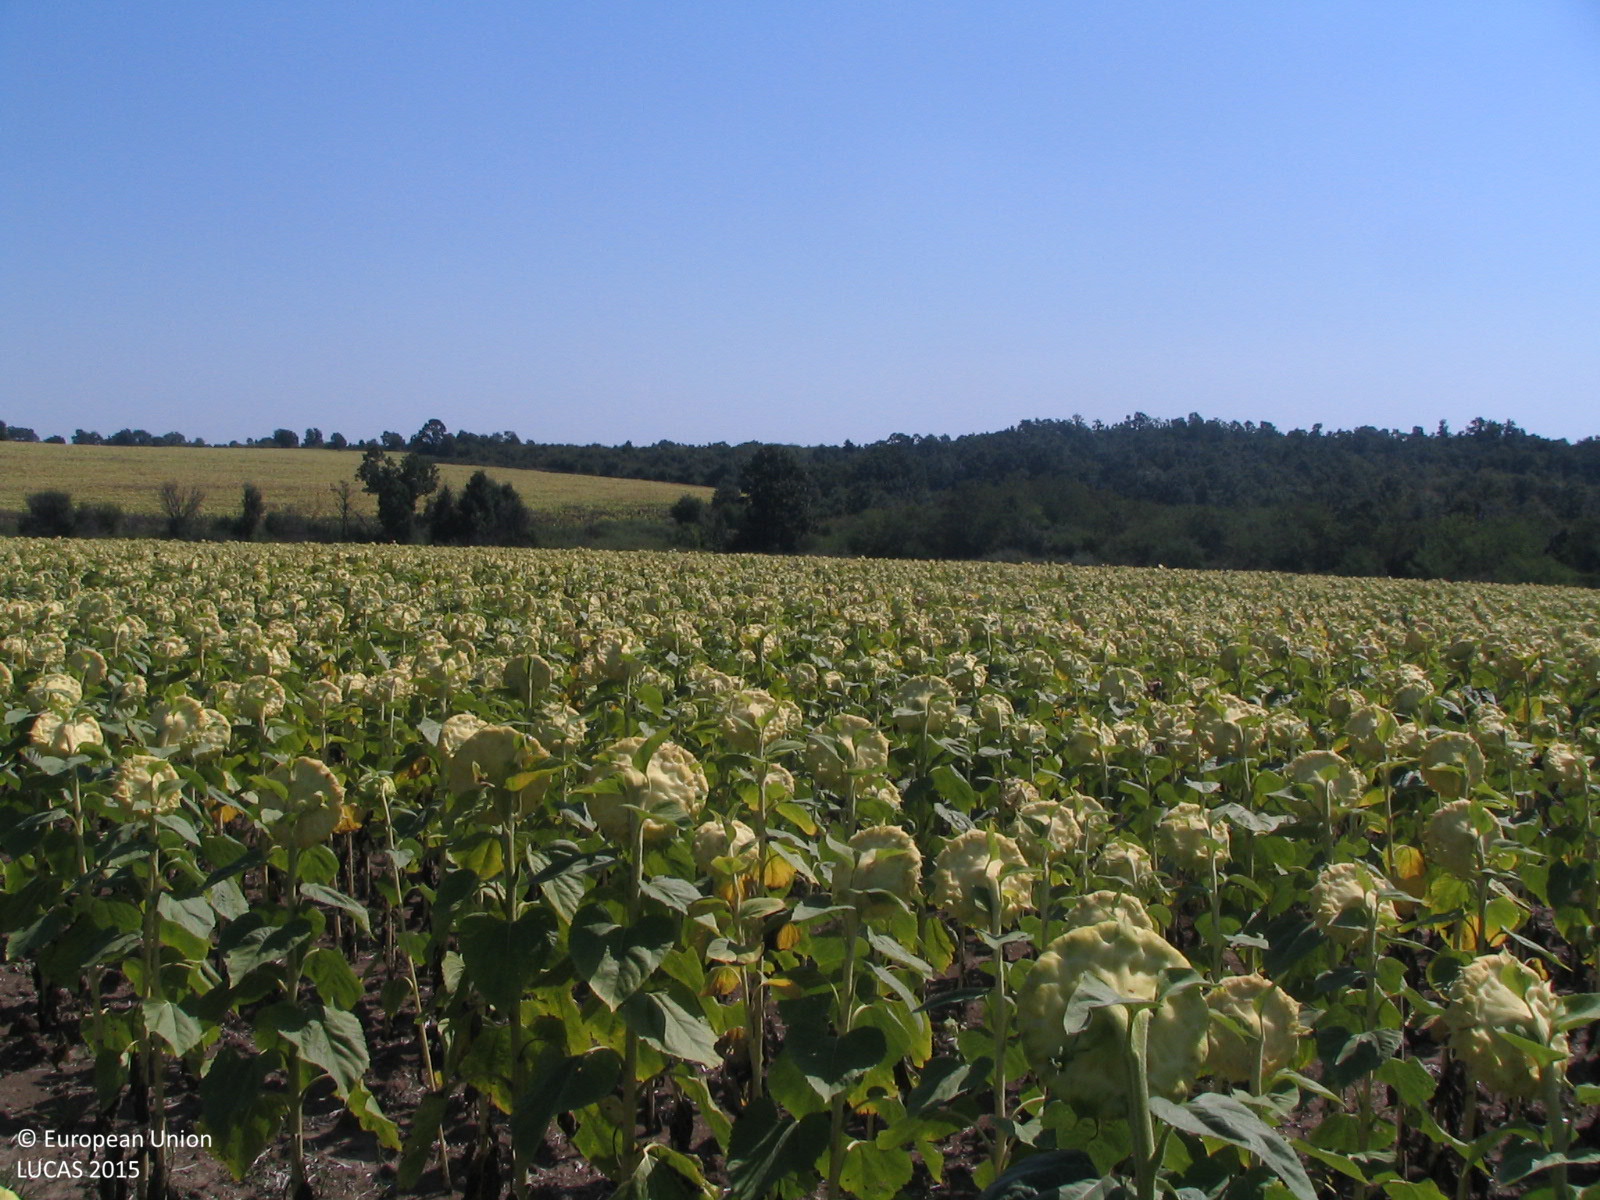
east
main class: Cropland
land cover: Sunflower
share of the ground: > 75 %
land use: Agriculture (excluding fallow land and kitchen gardens)
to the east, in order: Sunflower; Shrubland with sparse tree cover
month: August
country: BG
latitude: 43.1838
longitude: 24.3399
